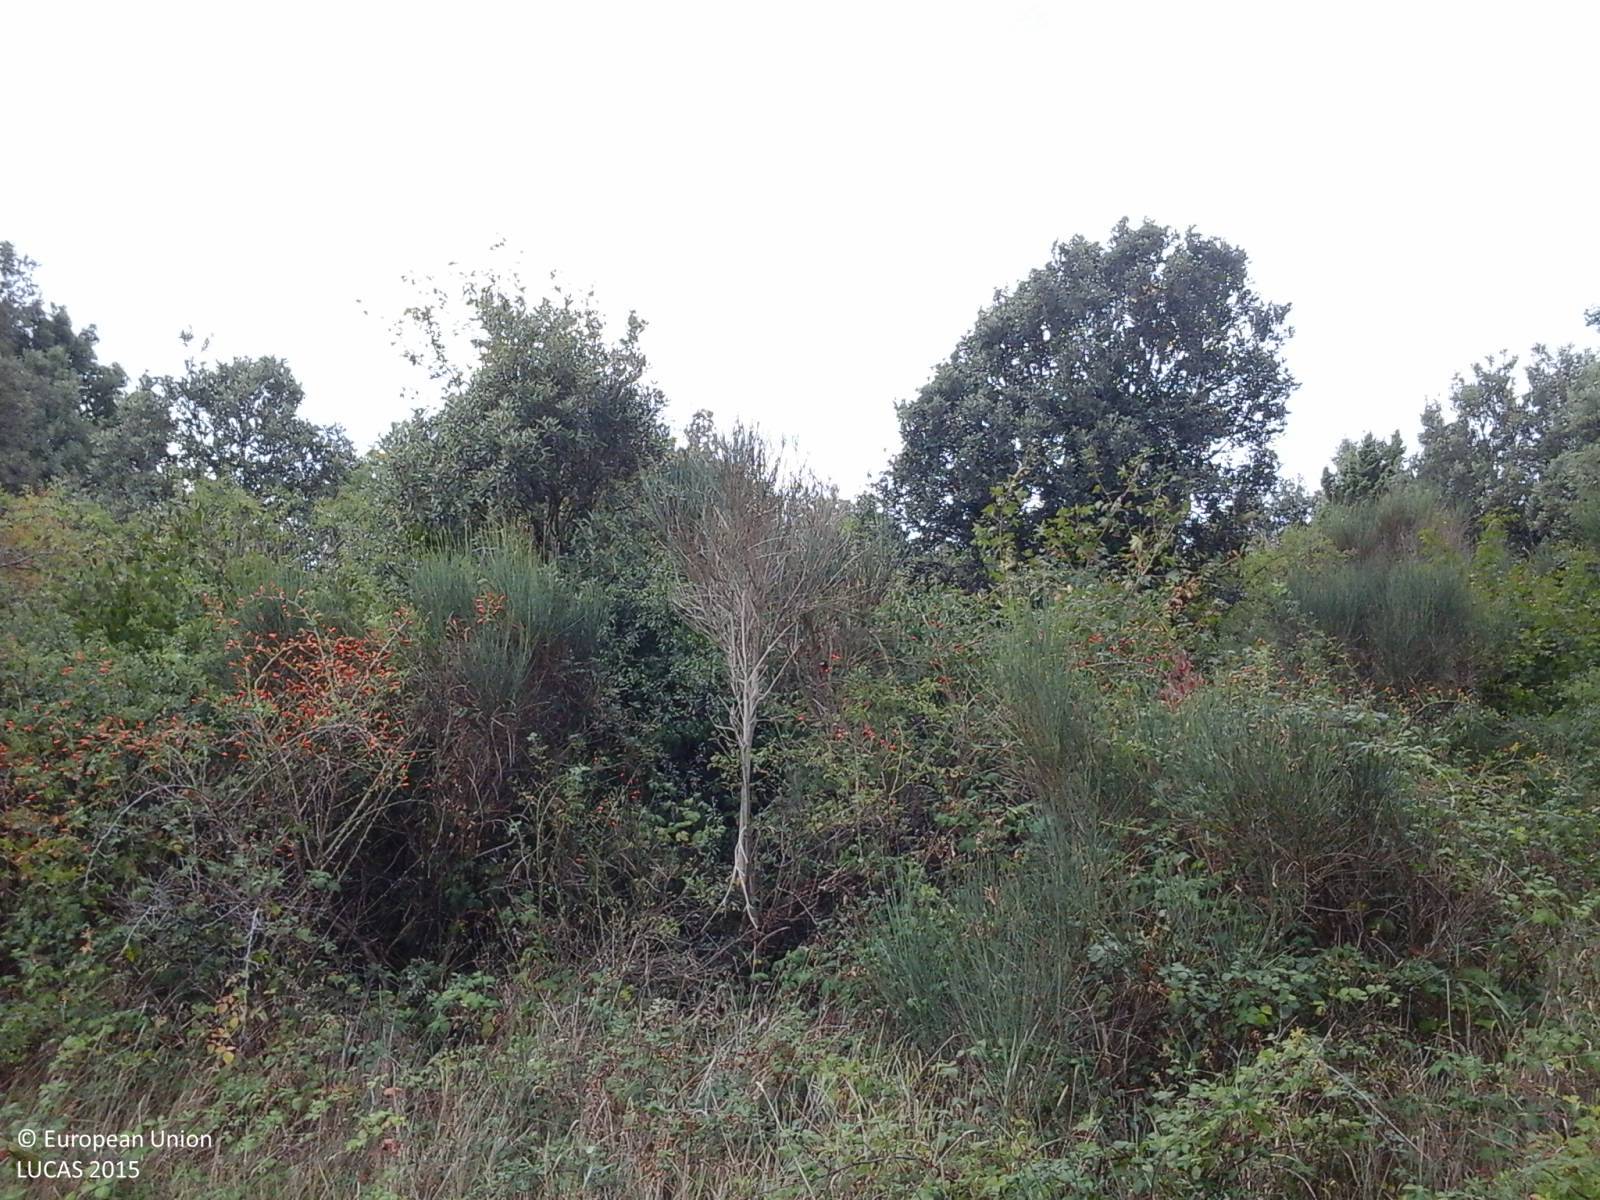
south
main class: Grassland
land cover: Grassland without tree/shrub cover
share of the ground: > 75 %
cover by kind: herbaceous plants 100 %
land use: Agriculture (excluding fallow land and kitchen gardens)
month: September
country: IT
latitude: 43.1333
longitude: 12.3167
